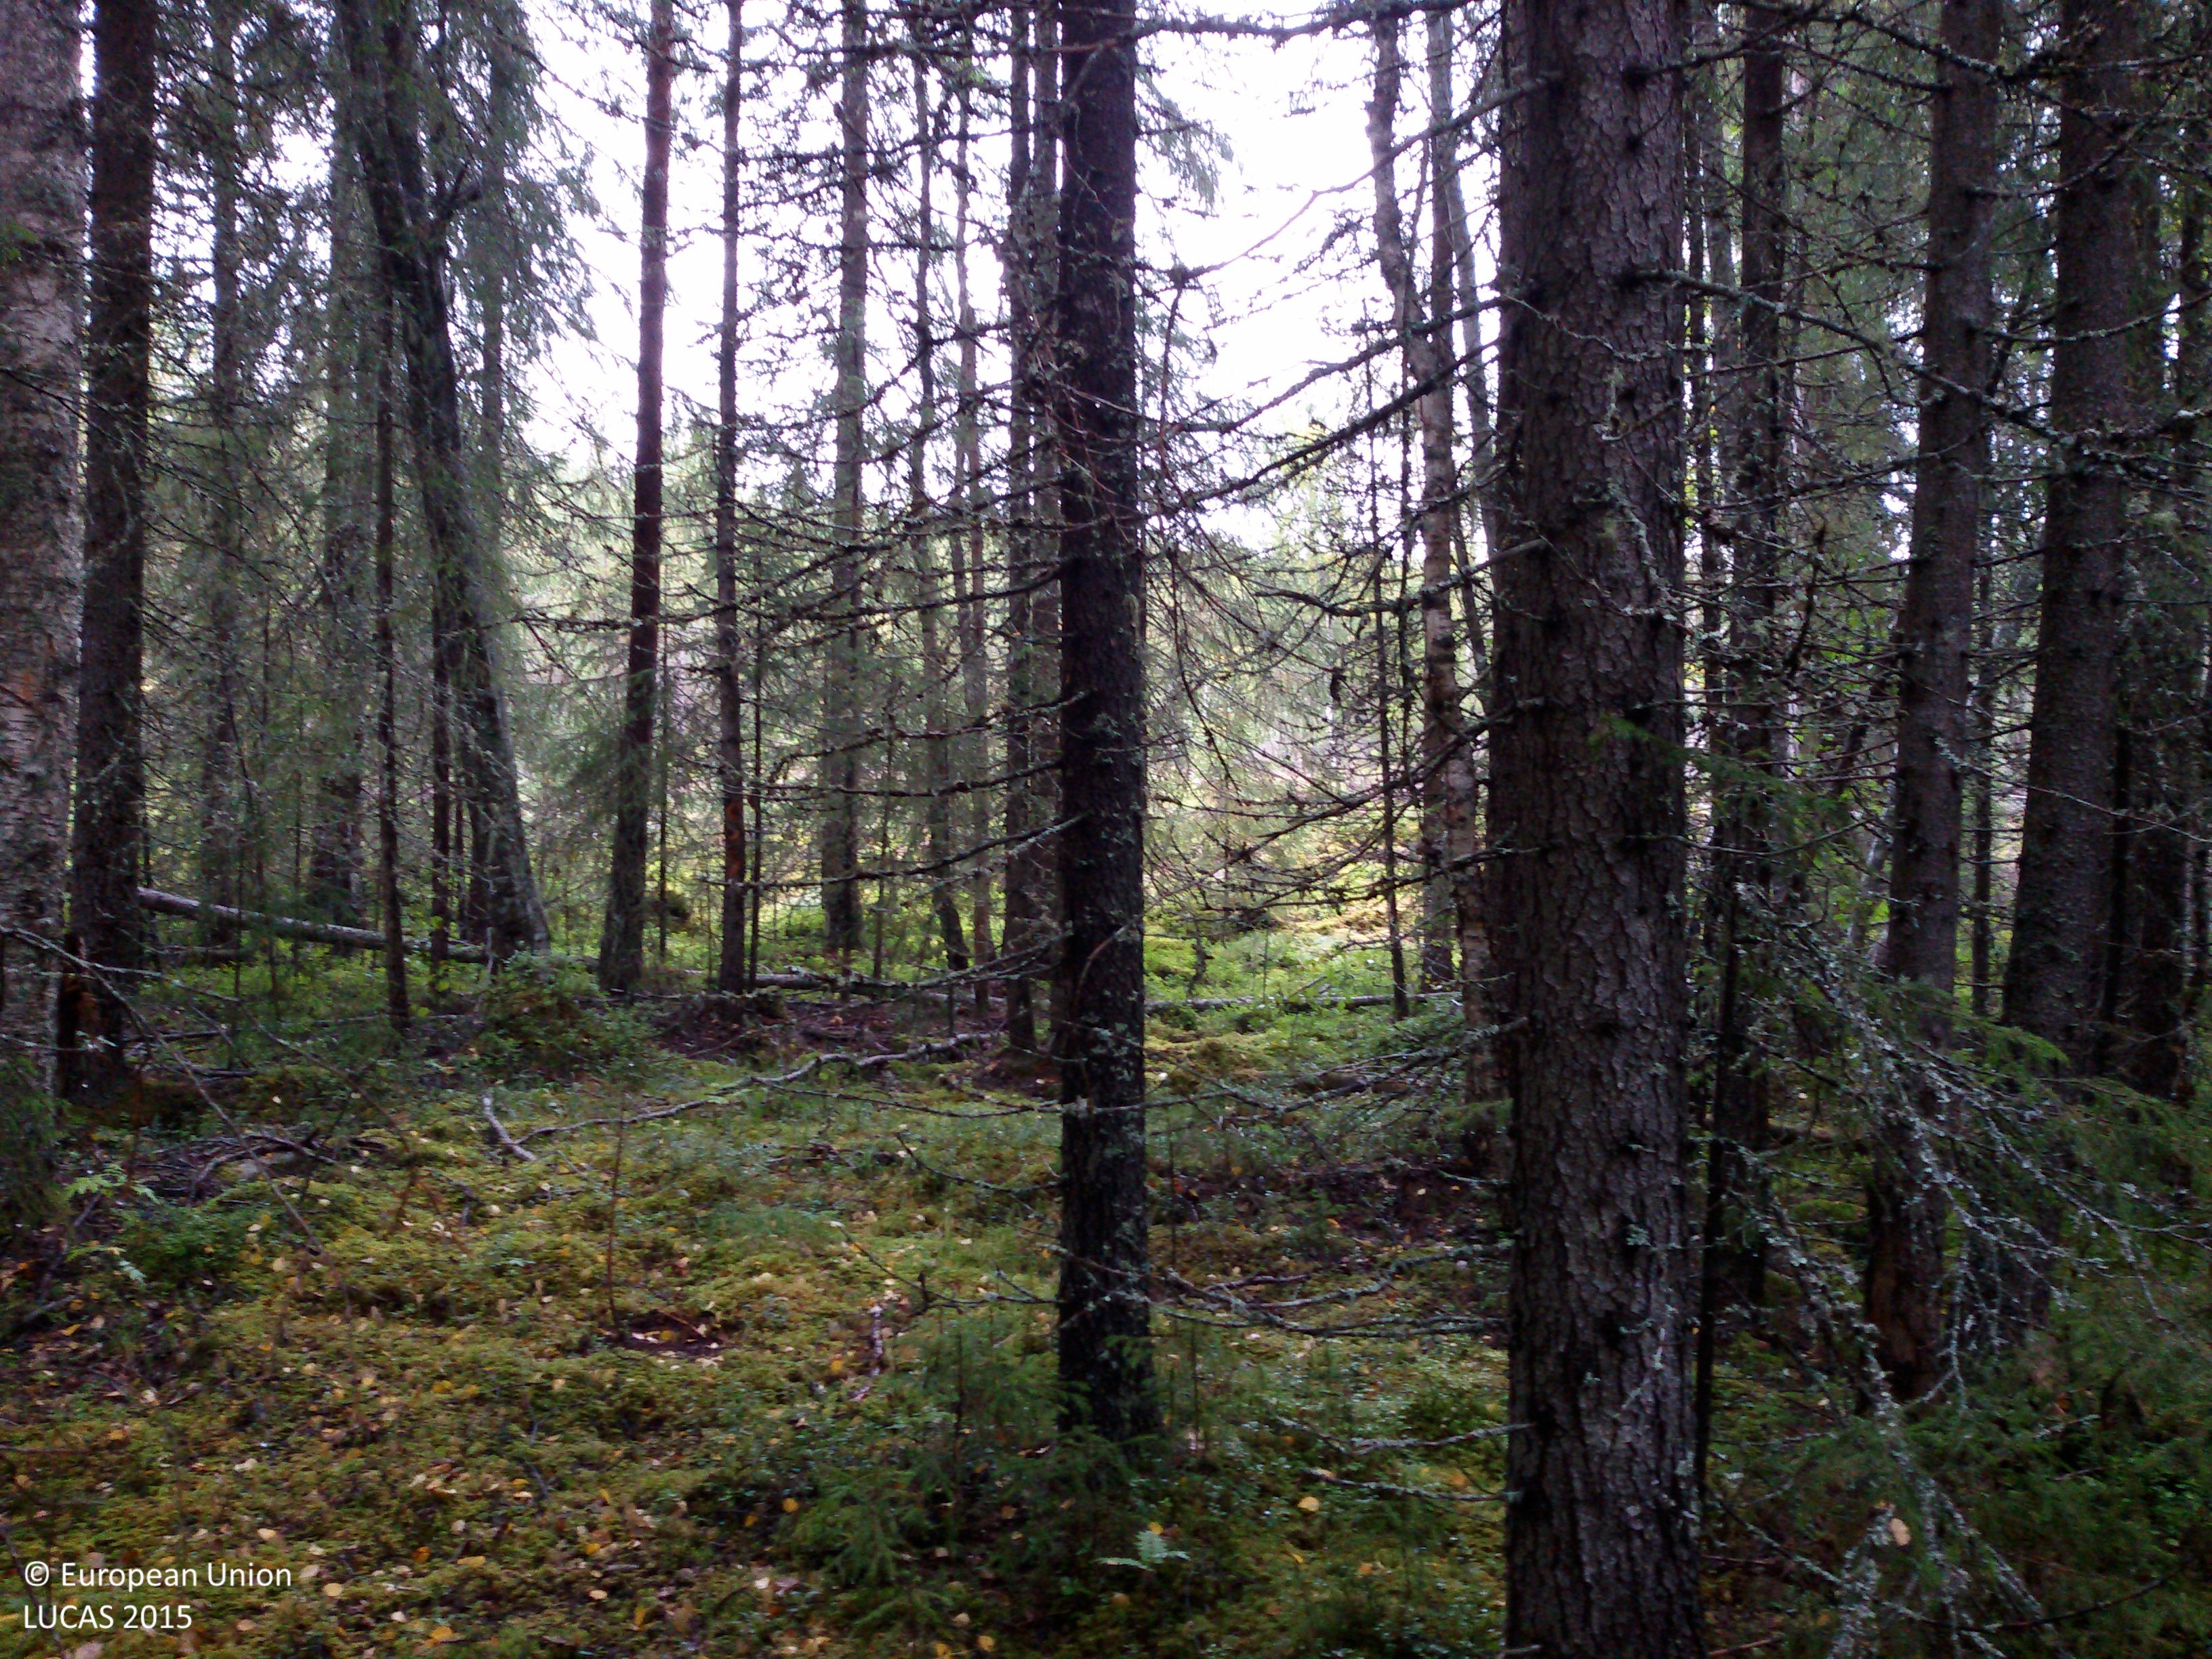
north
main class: Woodland
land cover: Spruce dominated coniferous woodland
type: boreal forest
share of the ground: > 75 %
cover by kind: coniferous forest trees 75 %, shrubs 10 %, lichens and mosses 10 %, broadleaved forest trees 5 %
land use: Forestry
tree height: > 5 m
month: September
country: SE
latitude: 60.8541
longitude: 14.3129
